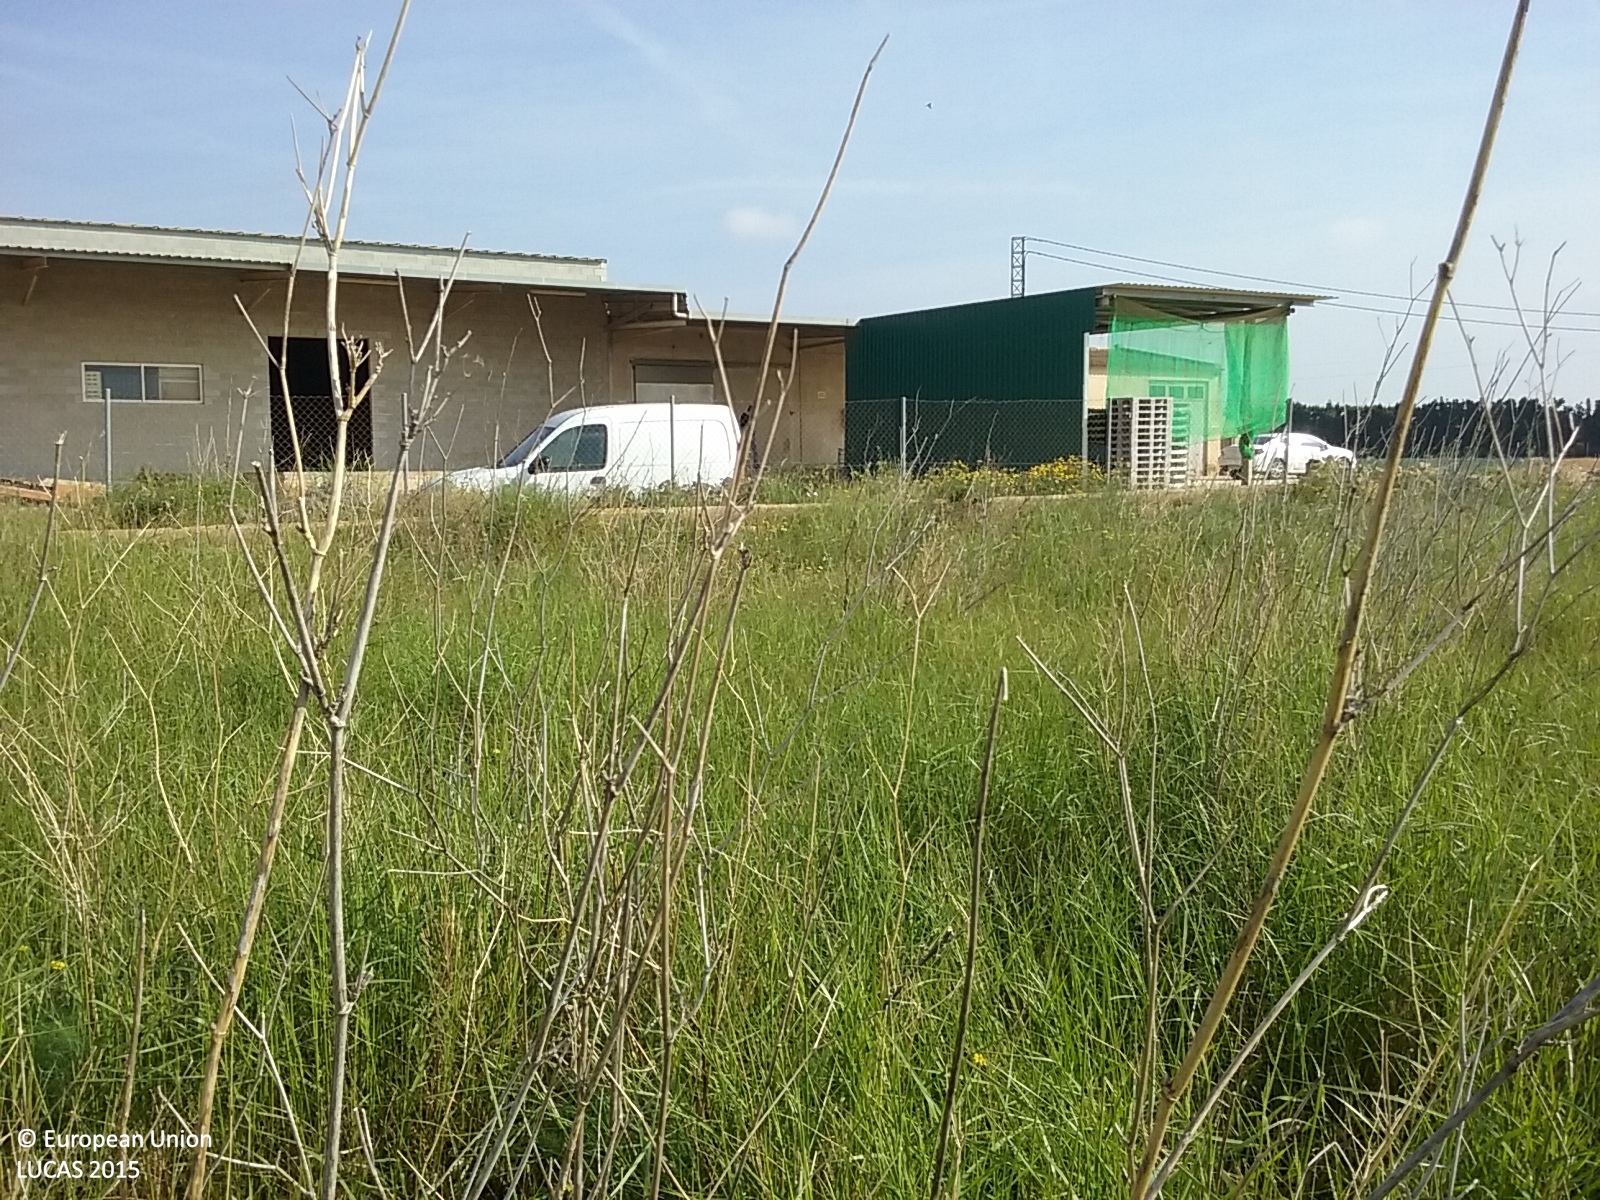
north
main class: Grassland
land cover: Grassland without tree/shrub cover
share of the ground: > 75 %
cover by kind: herbaceous plants 100 %
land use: Abandoned areas
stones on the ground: 10 - 25 %
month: April
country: ES
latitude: 40.7436
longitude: 0.6035
